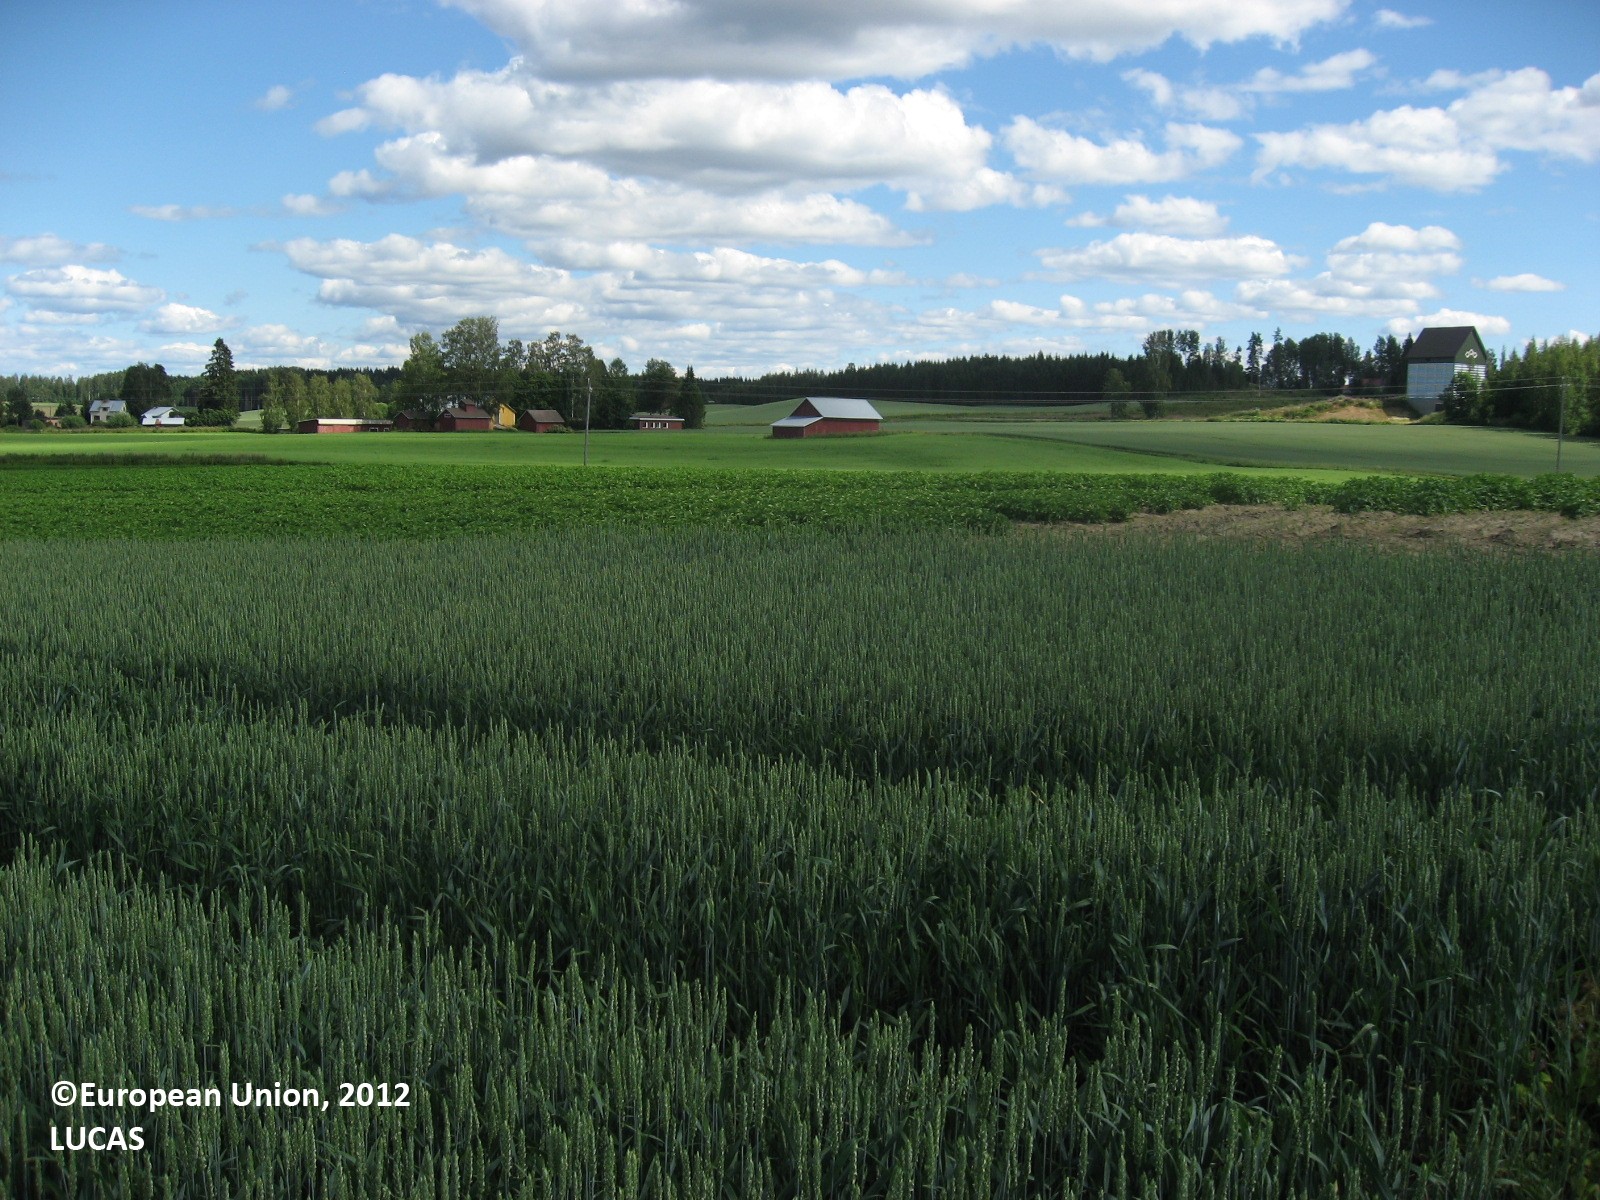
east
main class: Cropland
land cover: Common wheat
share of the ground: > 75 %
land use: Agriculture (excluding fallow land and kitchen gardens)
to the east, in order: Common wheat; Grass margins; Potatoes; Electric lines; Potatoes; Grass margins; Ditches and canals; Grass margins; Temporary grasslands
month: July
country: FI
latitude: 61.2086
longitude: 25.3644
